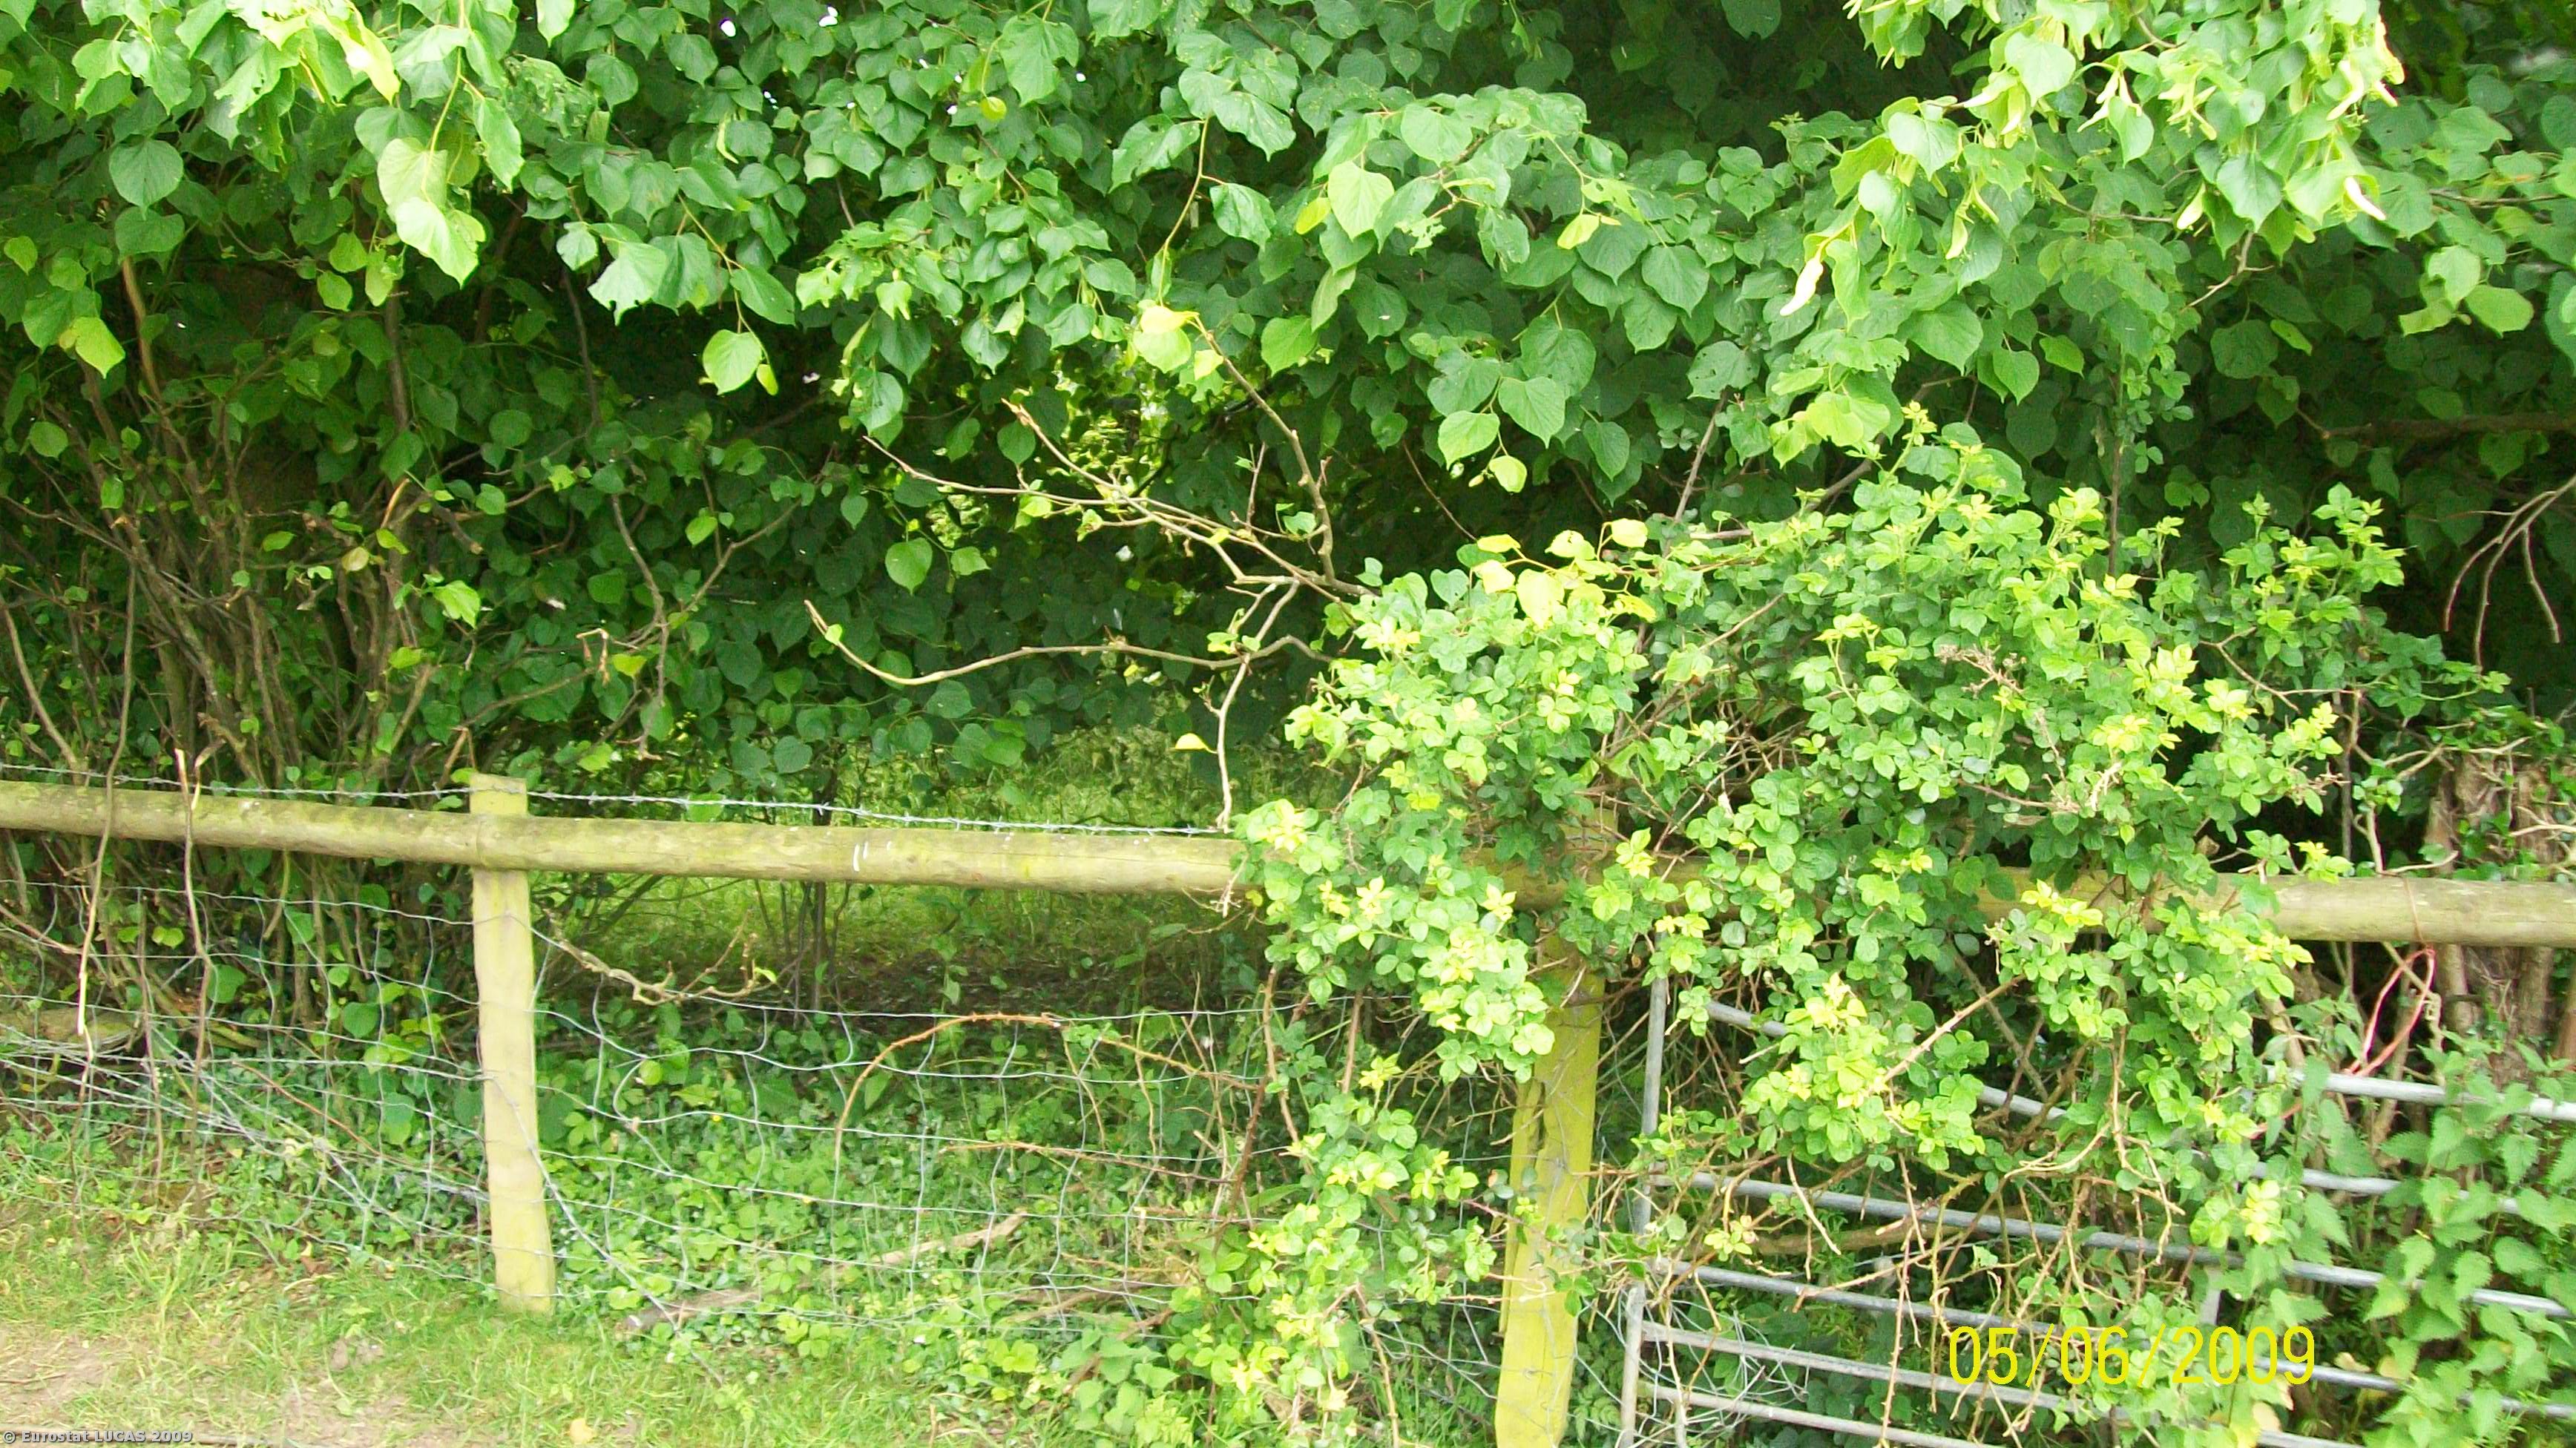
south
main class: Grassland
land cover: Grassland without tree/shrub cover
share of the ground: > 75 %
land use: Agriculture (excluding fallow land and kitchen gardens)
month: June
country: GB
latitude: 53.1243
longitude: -2.7574
